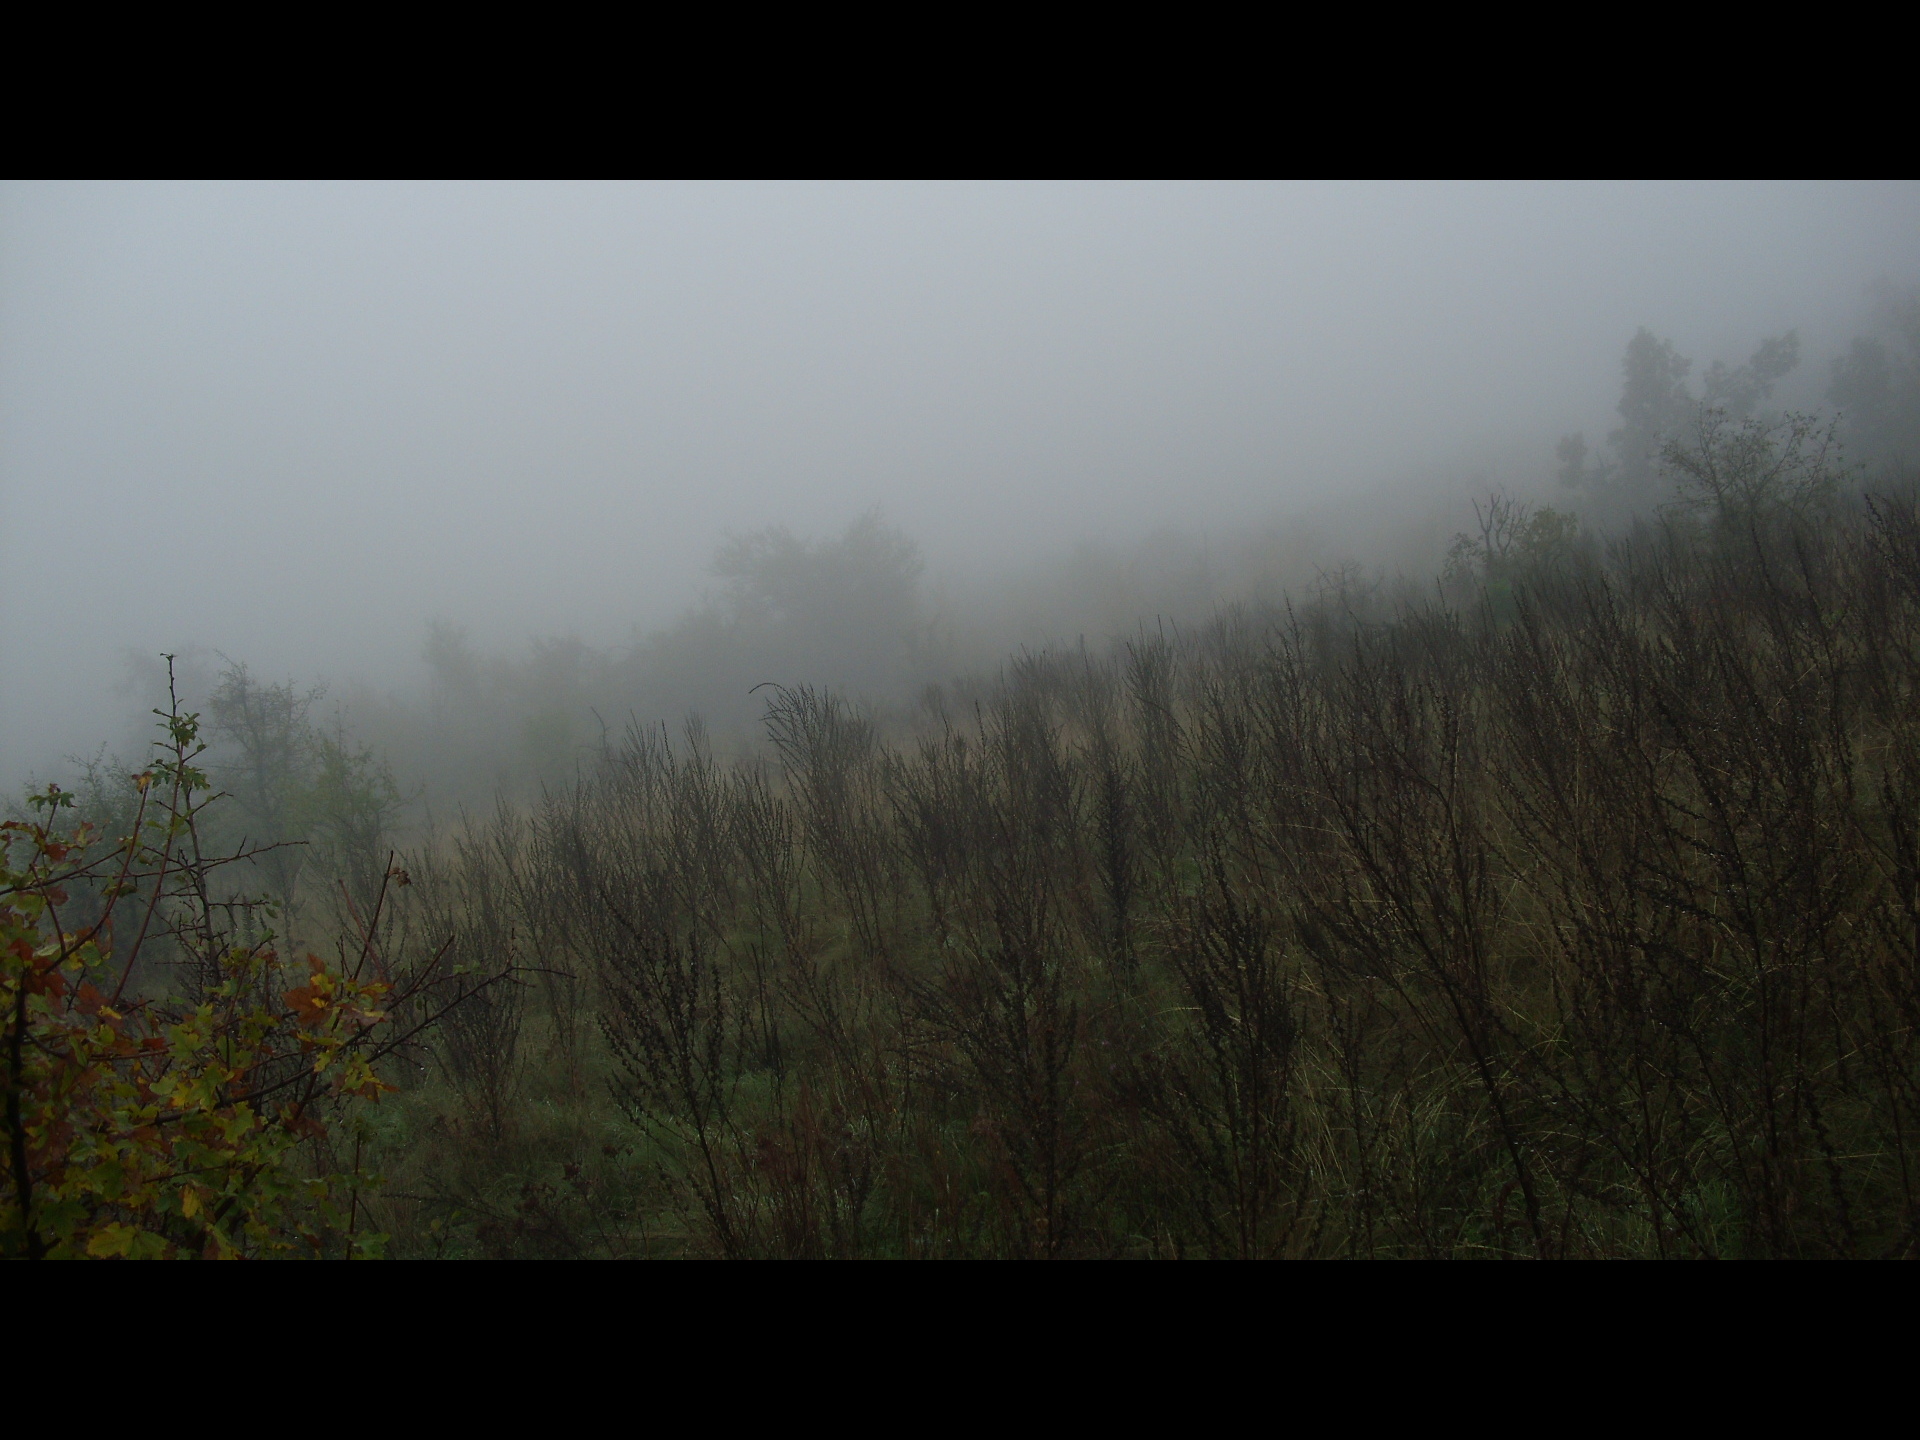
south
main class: Grassland
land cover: Grassland with sparse tree/shrub cover
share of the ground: > 75 %
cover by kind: herbaceous plants 85 %, shrubs 10 %, broadleaved forest trees 5 %
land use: Semi-natural and natural areas not in use
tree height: < 5 m
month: October
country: BG
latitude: 43.7628
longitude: 22.4408
